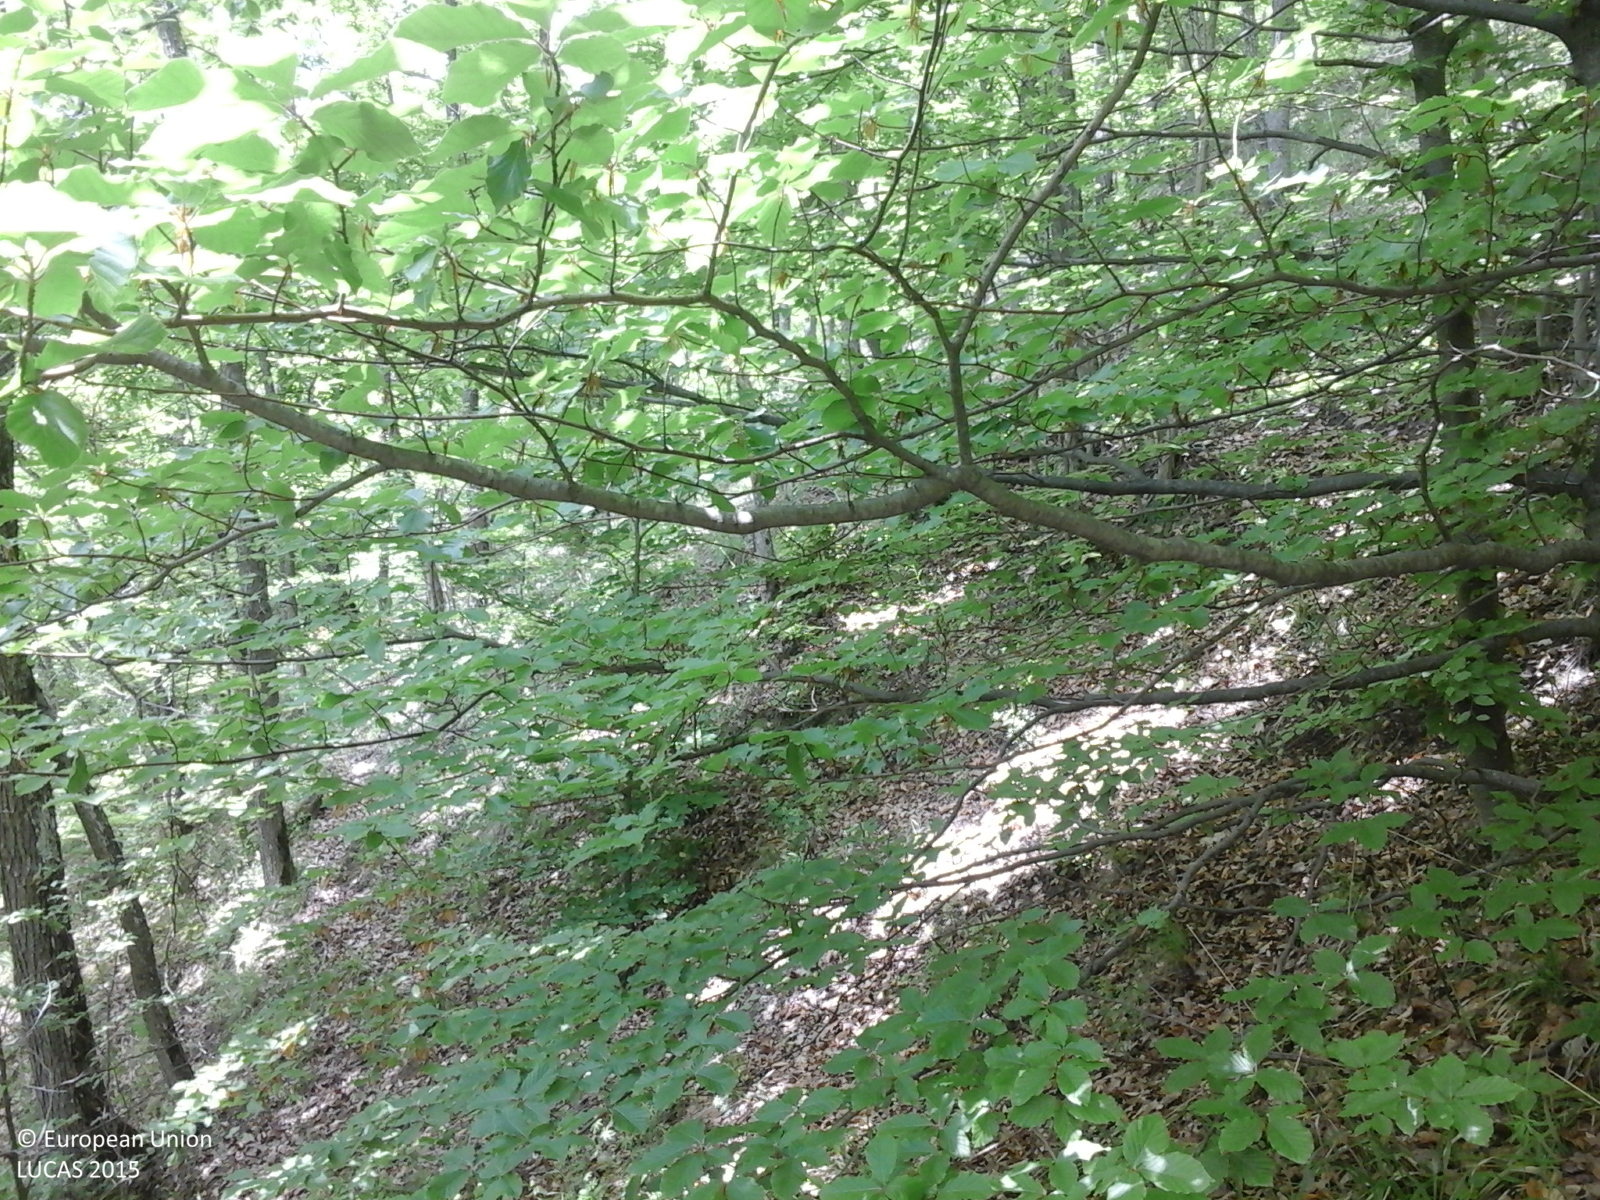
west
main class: Woodland
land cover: Broadleaved woodland
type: acidophilous oak and oak-birch forest
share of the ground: > 75 %
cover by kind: broadleaved forest trees 100 %
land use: Forestry
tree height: > 5 m
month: May
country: RO
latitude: 45.7617
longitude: 25.9937
